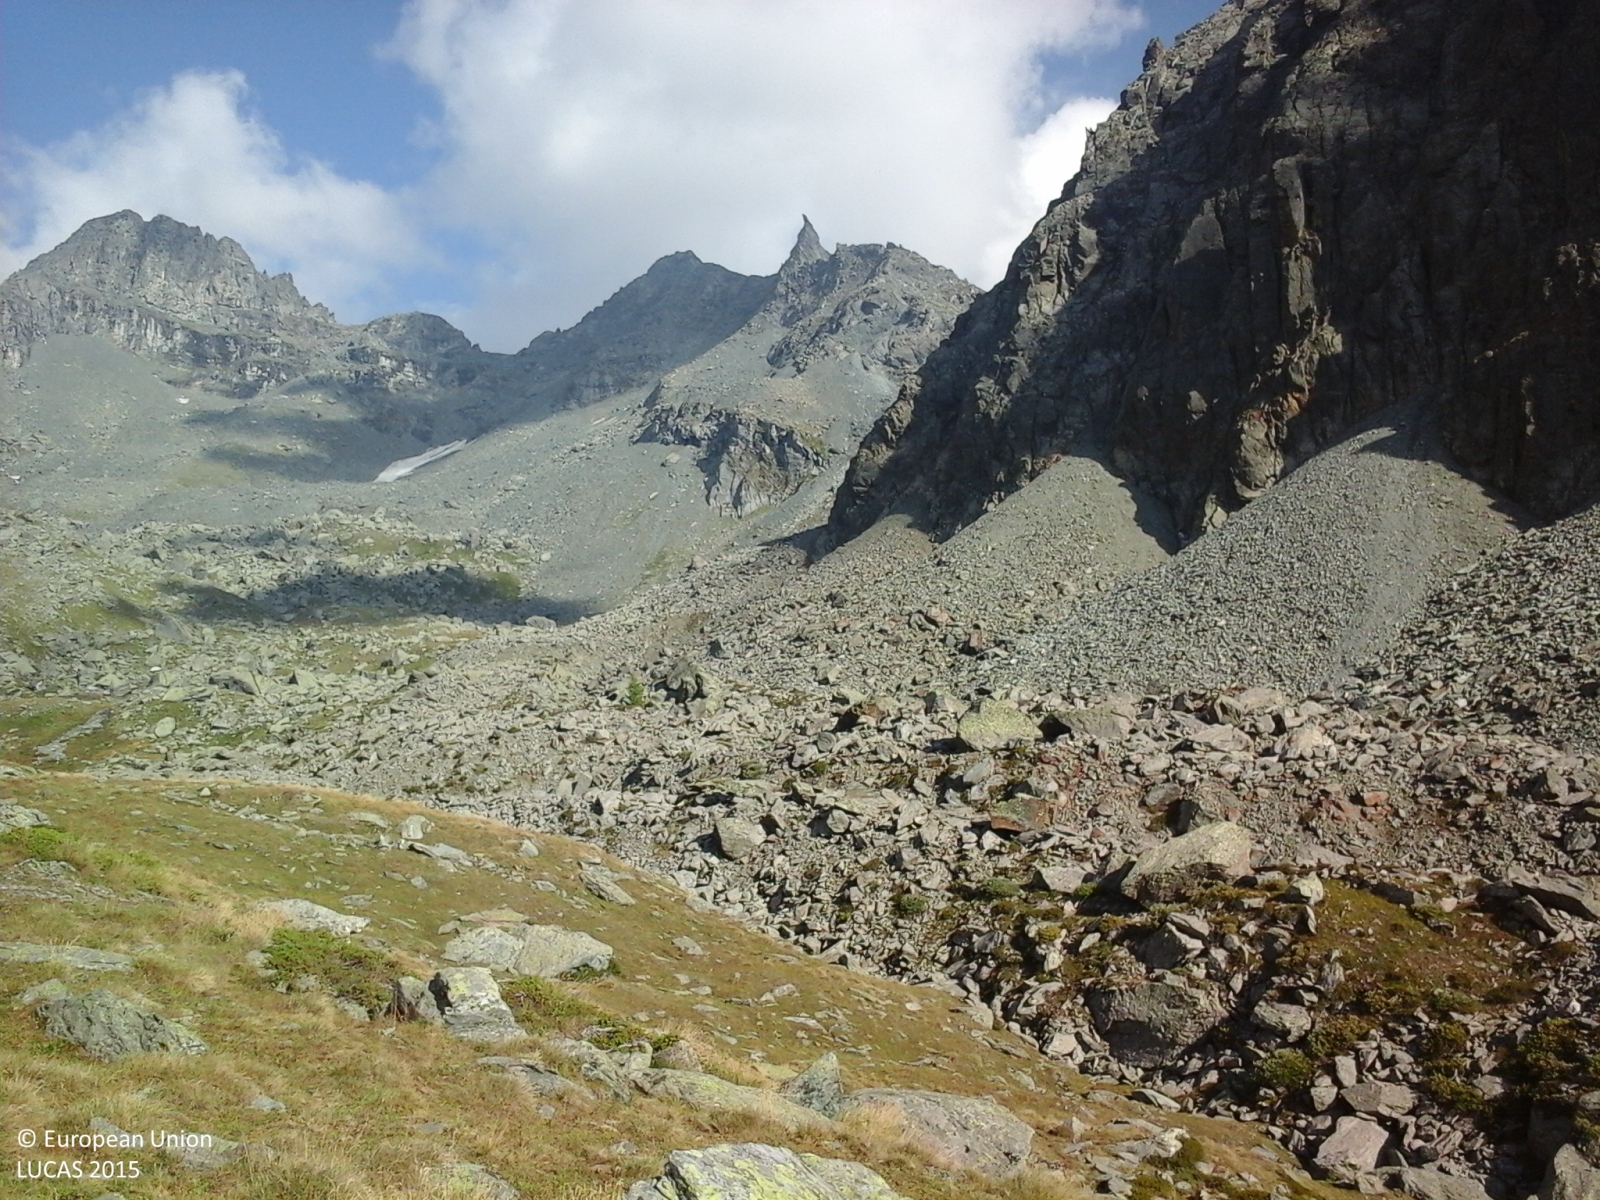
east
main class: Grassland
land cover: Grassland without tree/shrub cover
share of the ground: > 75 %
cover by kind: herbaceous plants 100 %
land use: Agriculture (excluding fallow land and kitchen gardens)
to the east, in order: Grassland without tree/shrub cover; Rocks and stones; Grassland without tree/shrub cover; Rocks and stones
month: August
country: IT
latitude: 45.8410
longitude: 7.7499
